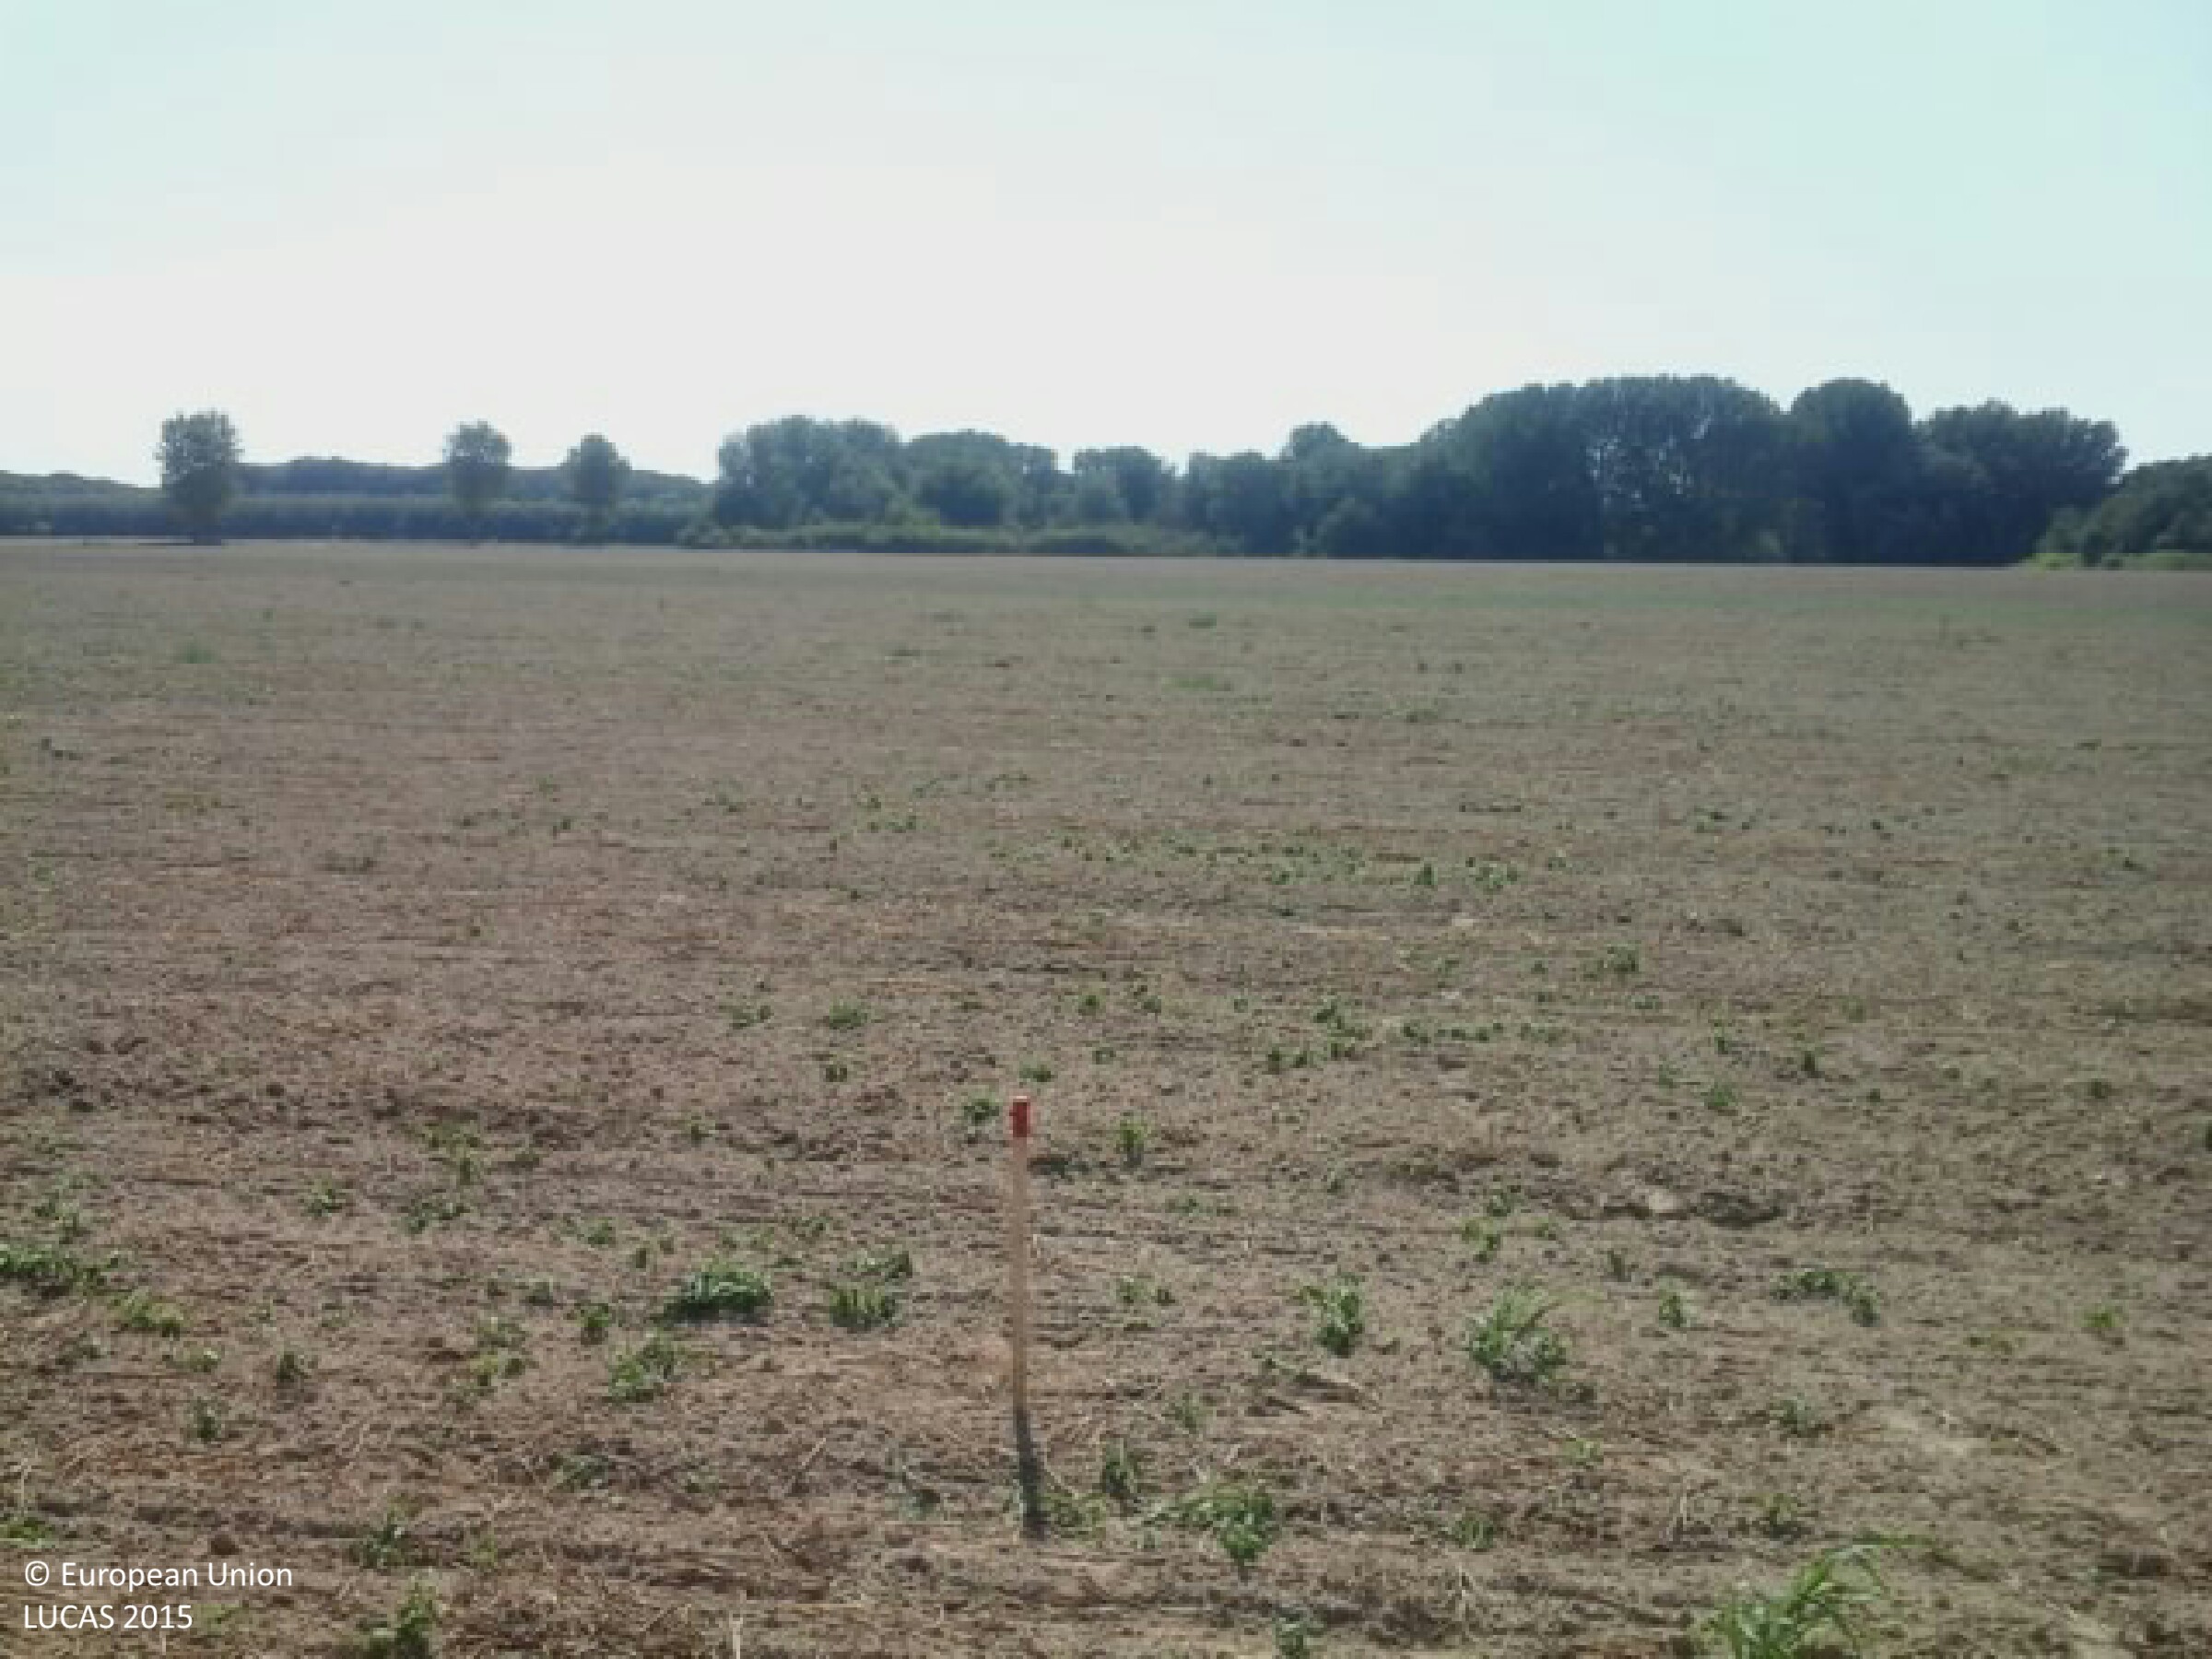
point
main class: Grassland
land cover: Spontaneously vegetated surfaces
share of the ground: 10 - 25 %
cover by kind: unconsolidated bare surface 90 %, herbaceous plants 10 %
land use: Fallow land
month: July
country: HU
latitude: 46.2188
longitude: 17.1715
